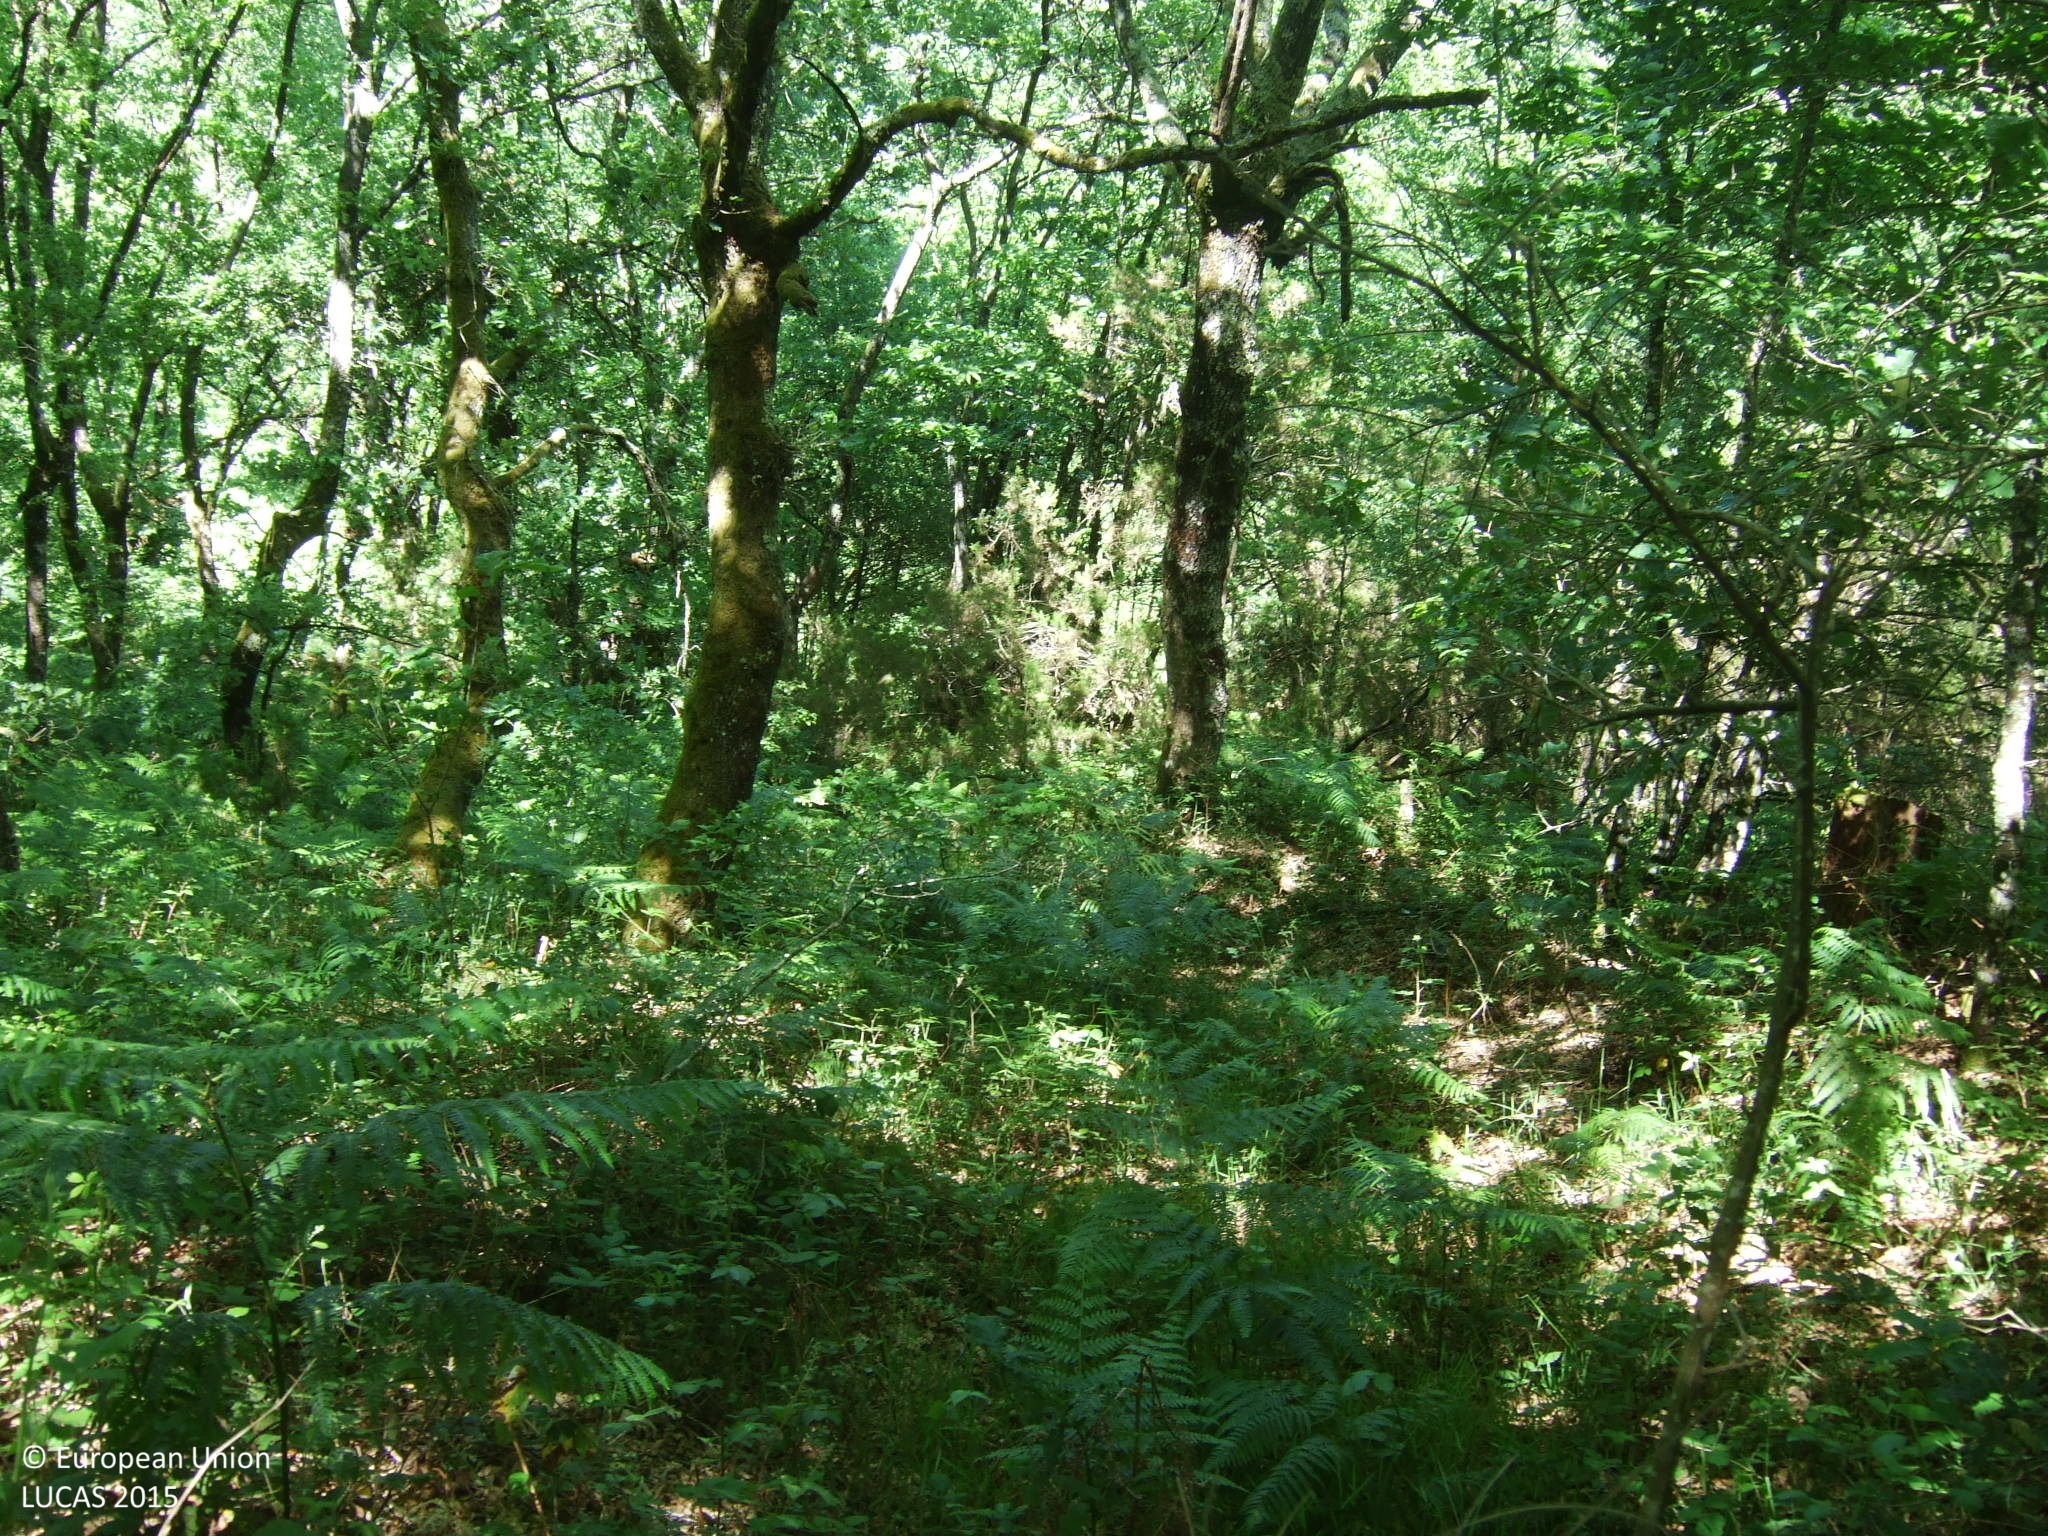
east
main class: Woodland
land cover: Broadleaved woodland
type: acidophilous oak and oak-birch forest
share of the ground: > 75 %
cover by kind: broadleaved forest trees 80 %, shrubs 20 %
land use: Forestry
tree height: > 5 m
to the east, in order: Broadleaved woodland; Tracks; Broadleaved woodland; Tracks; Broadleaved woodland; Fences; Grassland without tree/shrub cover; Fences; Grassland without tree/shrub cover
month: May
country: ES
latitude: 42.7031
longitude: -7.4925
